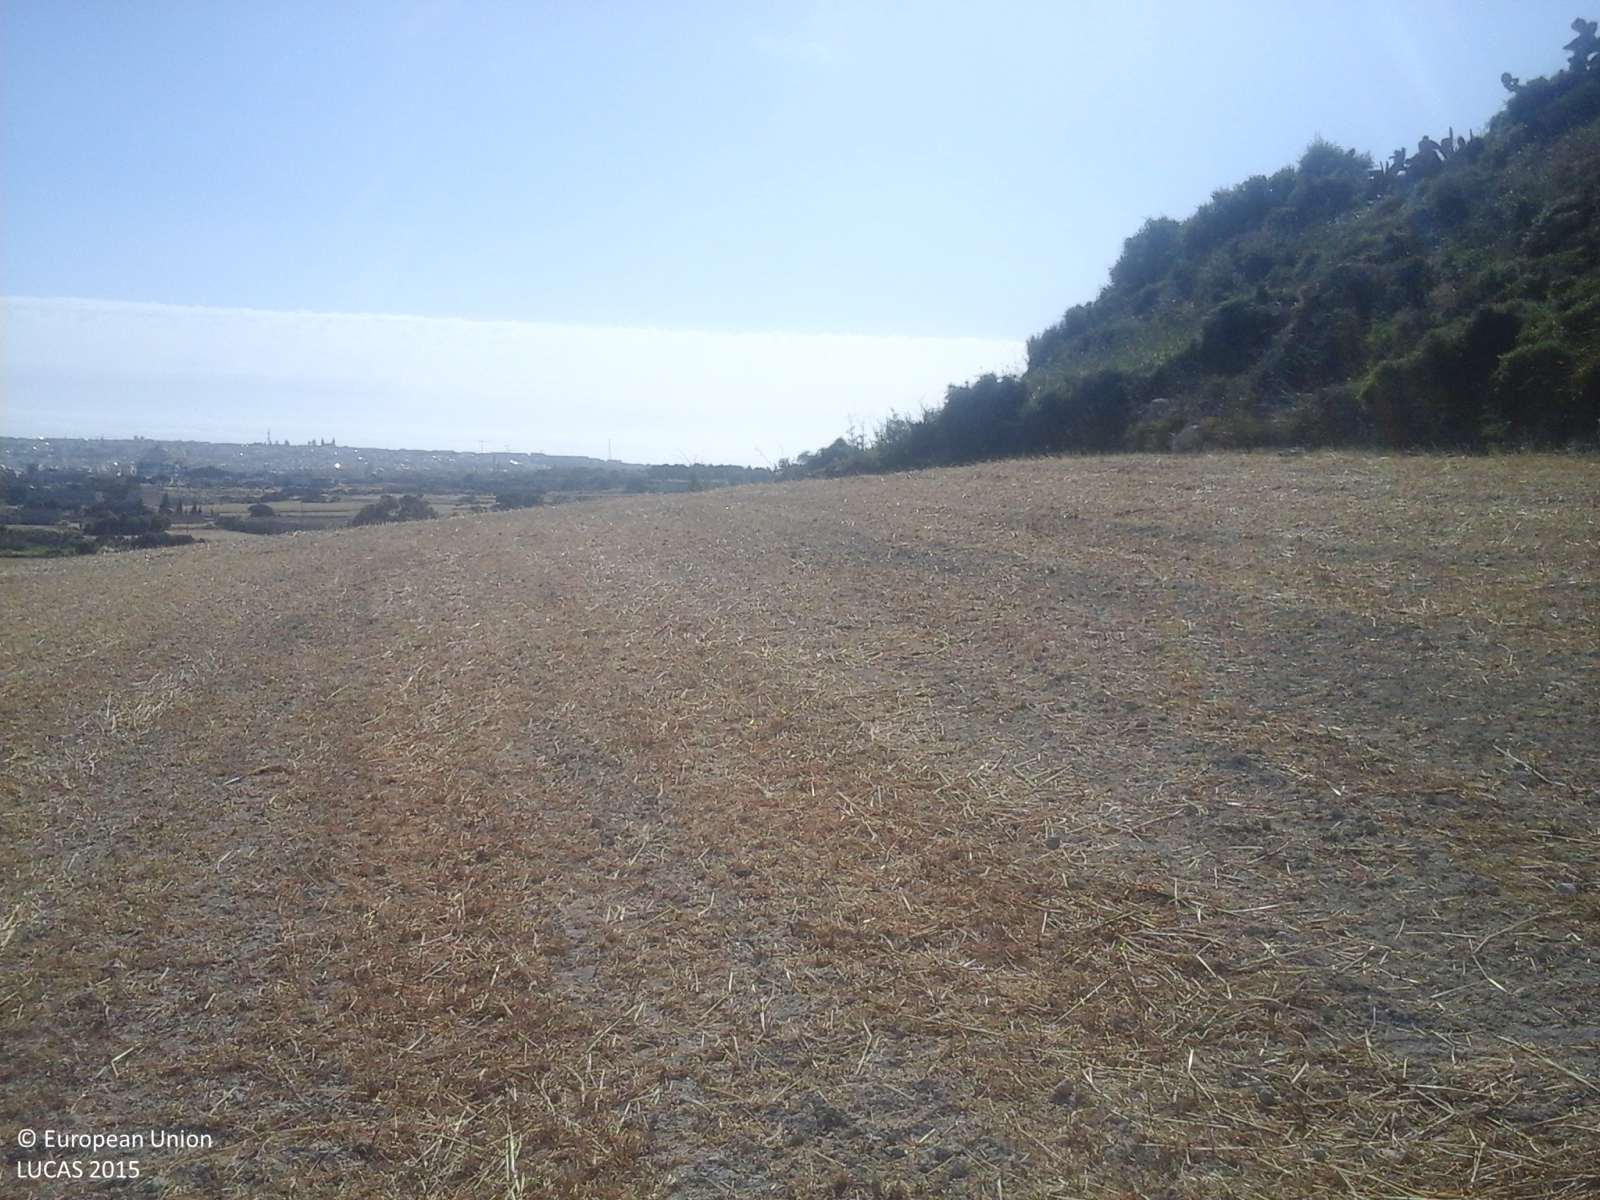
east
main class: Cropland
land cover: Mixed cereals for fodder
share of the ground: > 75 %
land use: Agriculture (excluding fallow land and kitchen gardens)
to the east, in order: Mixed cereals for fodder; Grass margins; Mixed cereals for fodder; Shrubland with sparse tree cover; Mixed cereals for fodder; Grassland without tree/shrub cover; Mixed cereals for fodder; Lines of trees; Vineyards; Other fruit trees and berries; Pear fruit
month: May
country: MT
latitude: 35.8987
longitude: 14.4021
